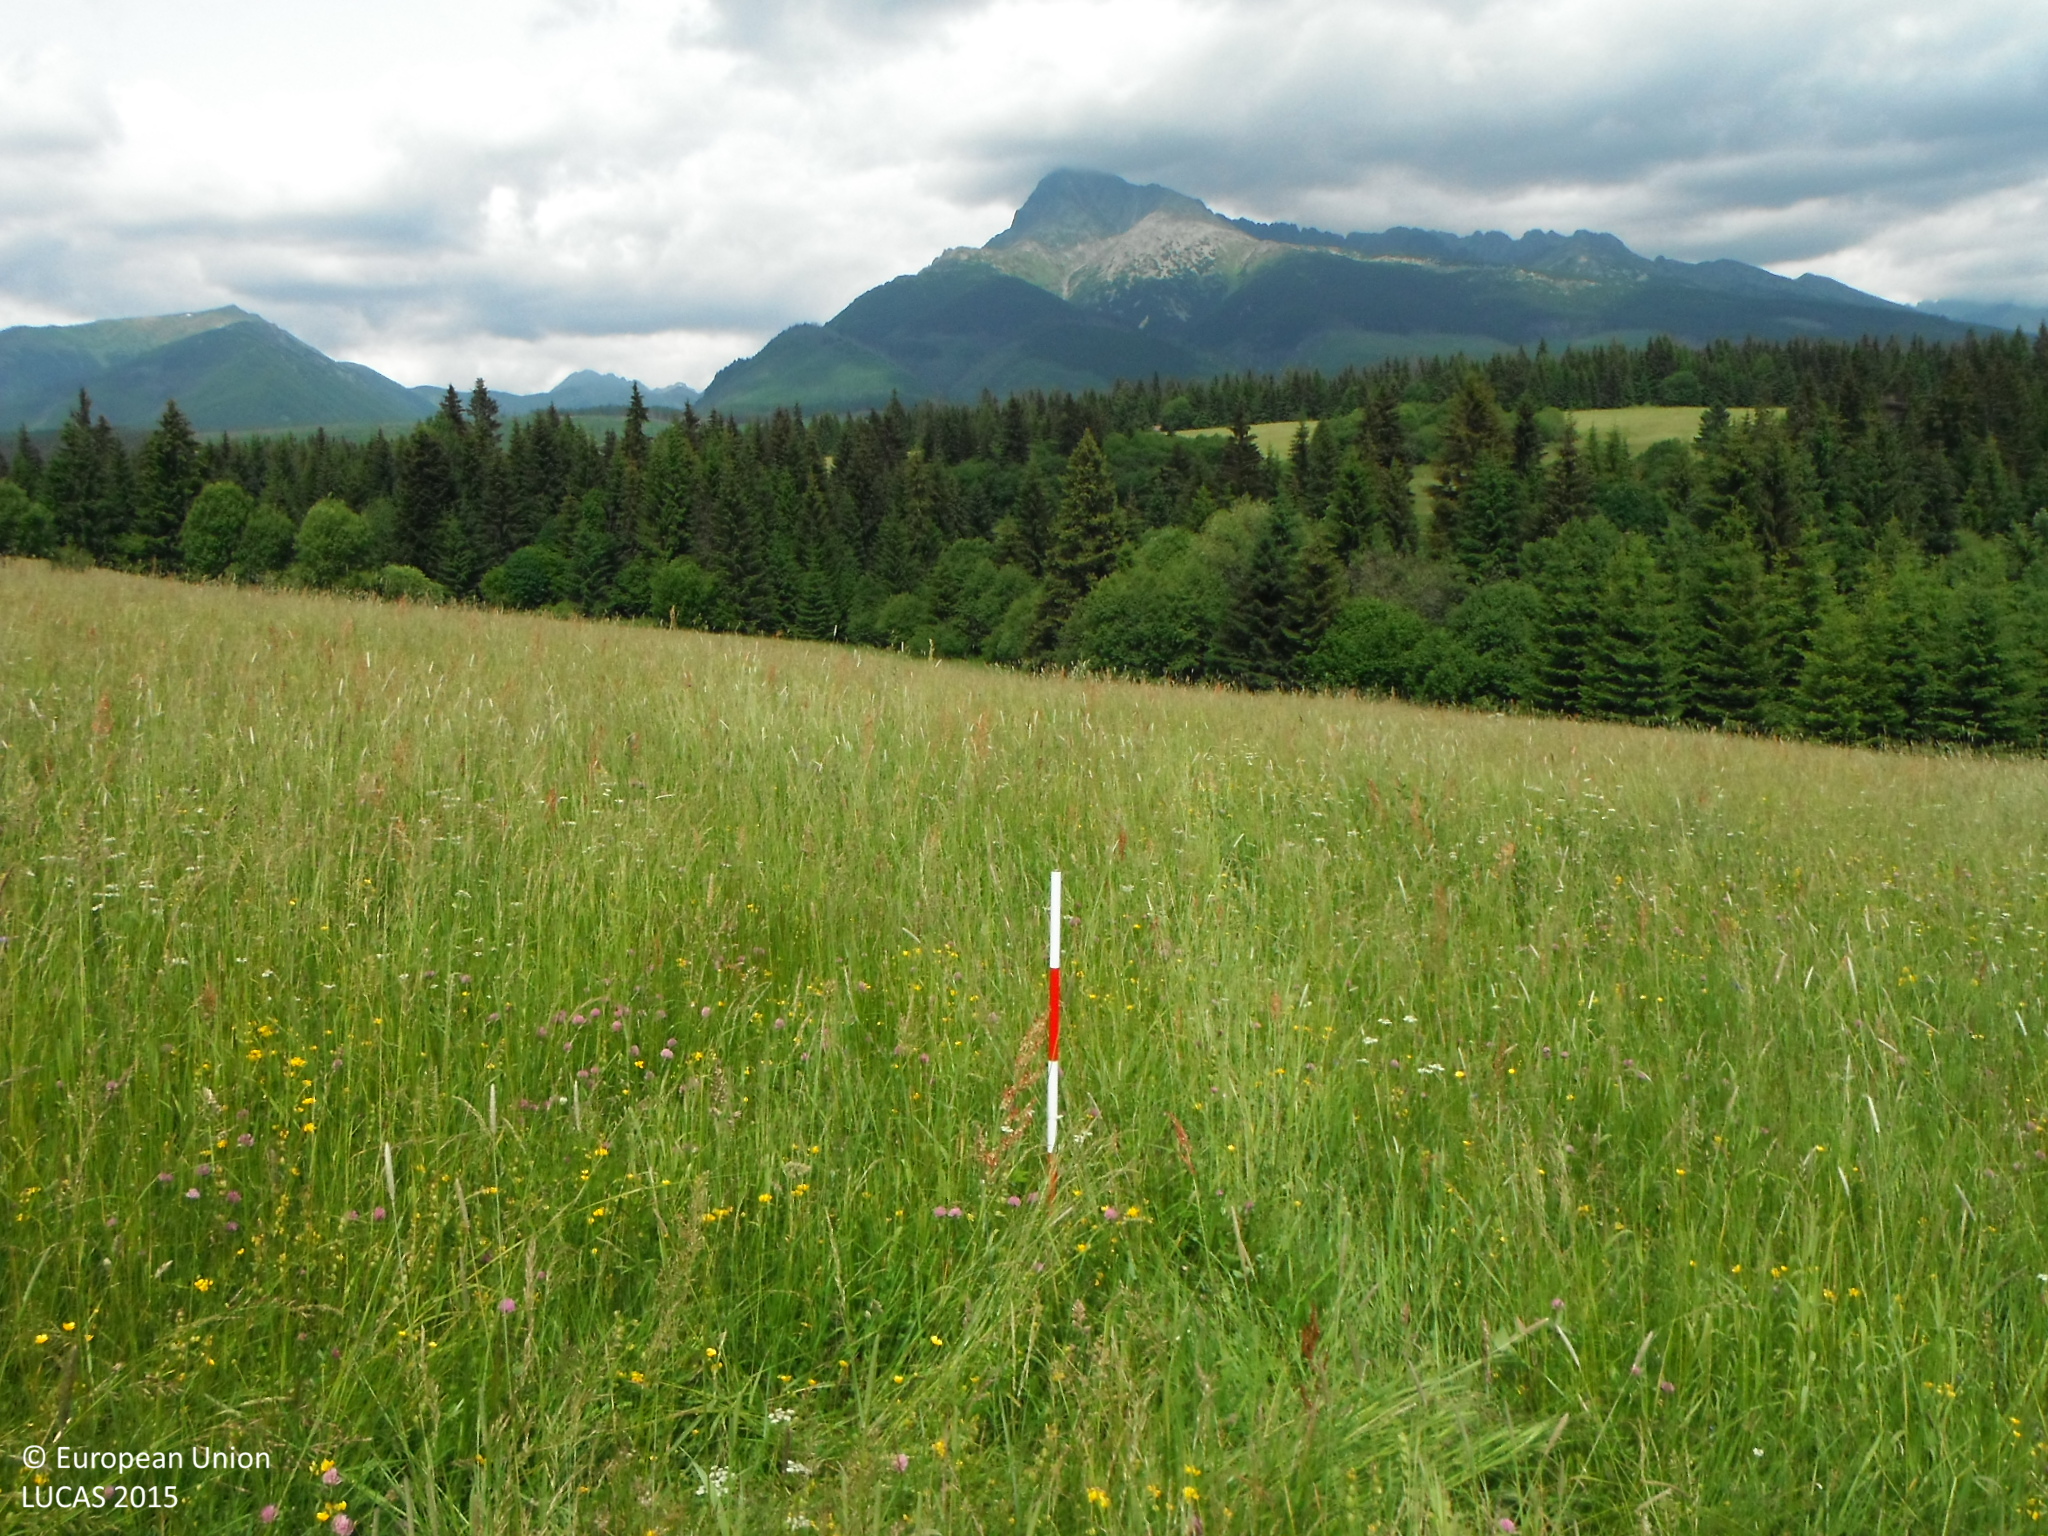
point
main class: Grassland
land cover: Grassland without tree/shrub cover
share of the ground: > 75 %
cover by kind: herbaceous plants 100 %
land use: Agriculture (excluding fallow land and kitchen gardens)
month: June
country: SK
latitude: 49.1149
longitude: 19.9357
